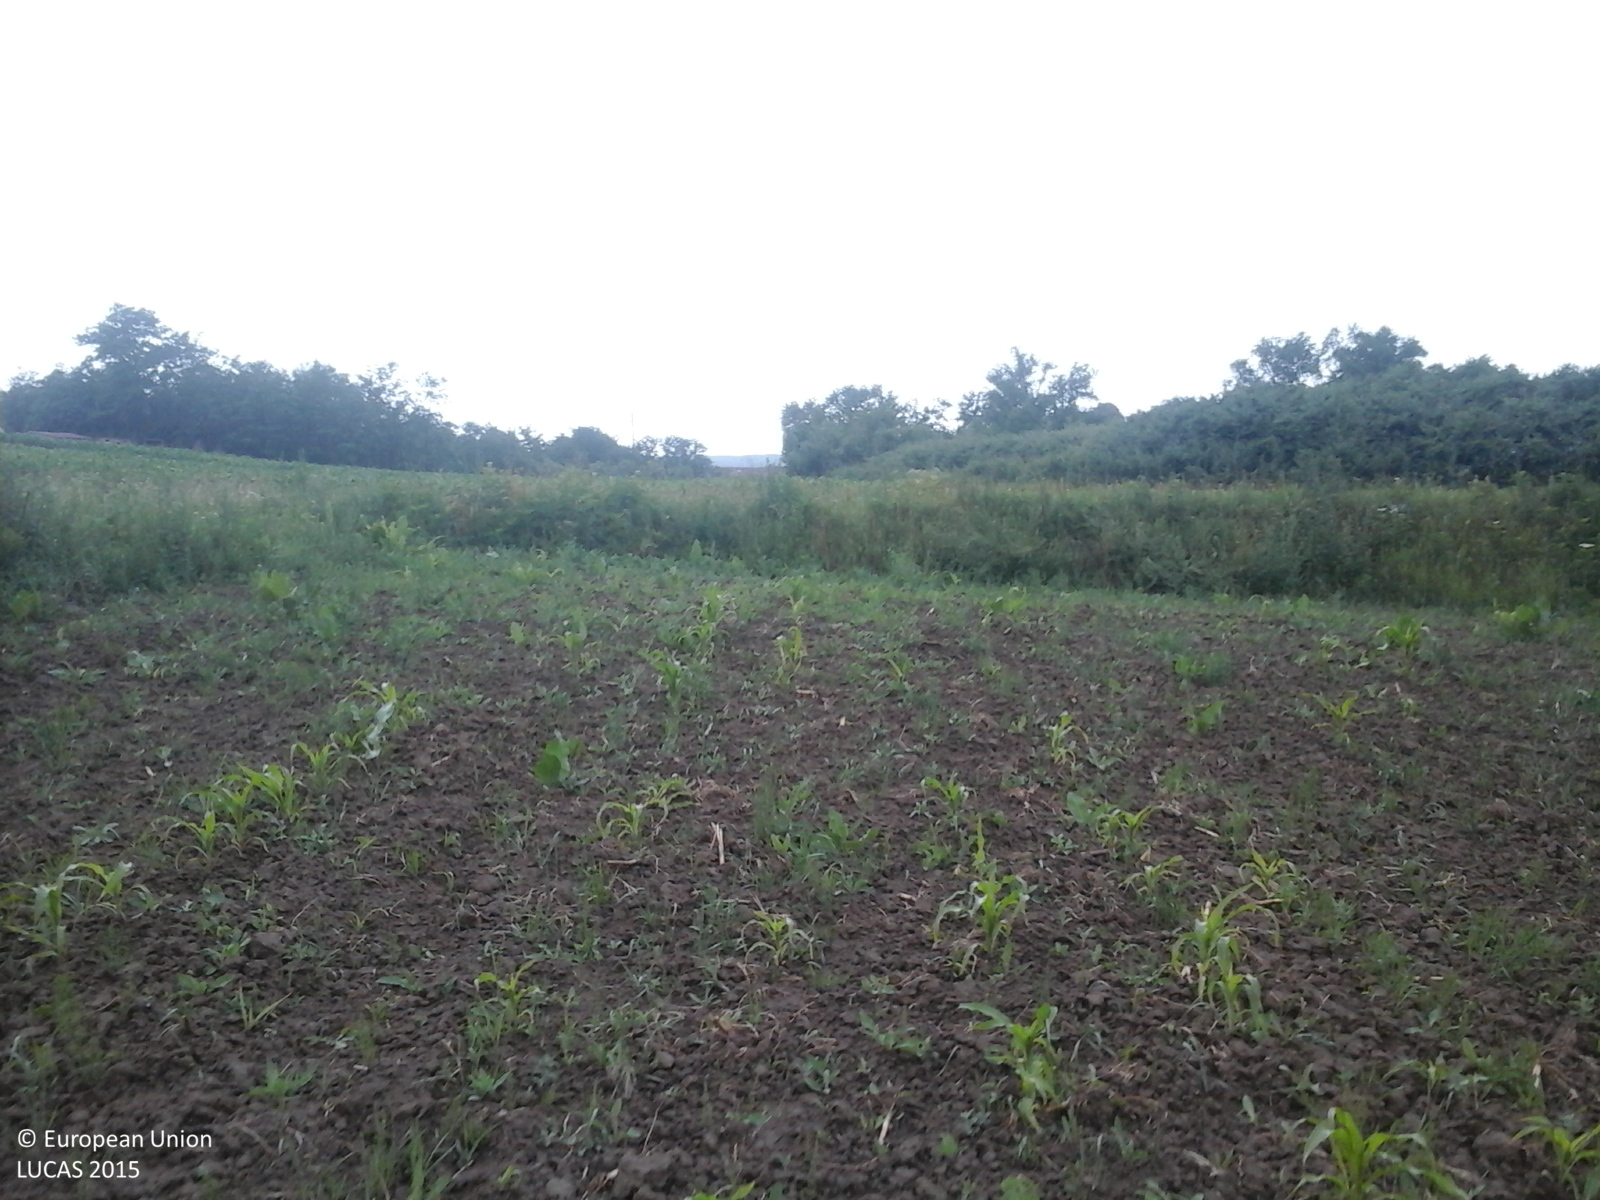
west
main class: Cropland
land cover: Maize
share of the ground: 25 - 50 %
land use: Agriculture (excluding fallow land and kitchen gardens)
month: June
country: RO
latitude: 47.8622
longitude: 26.3001
